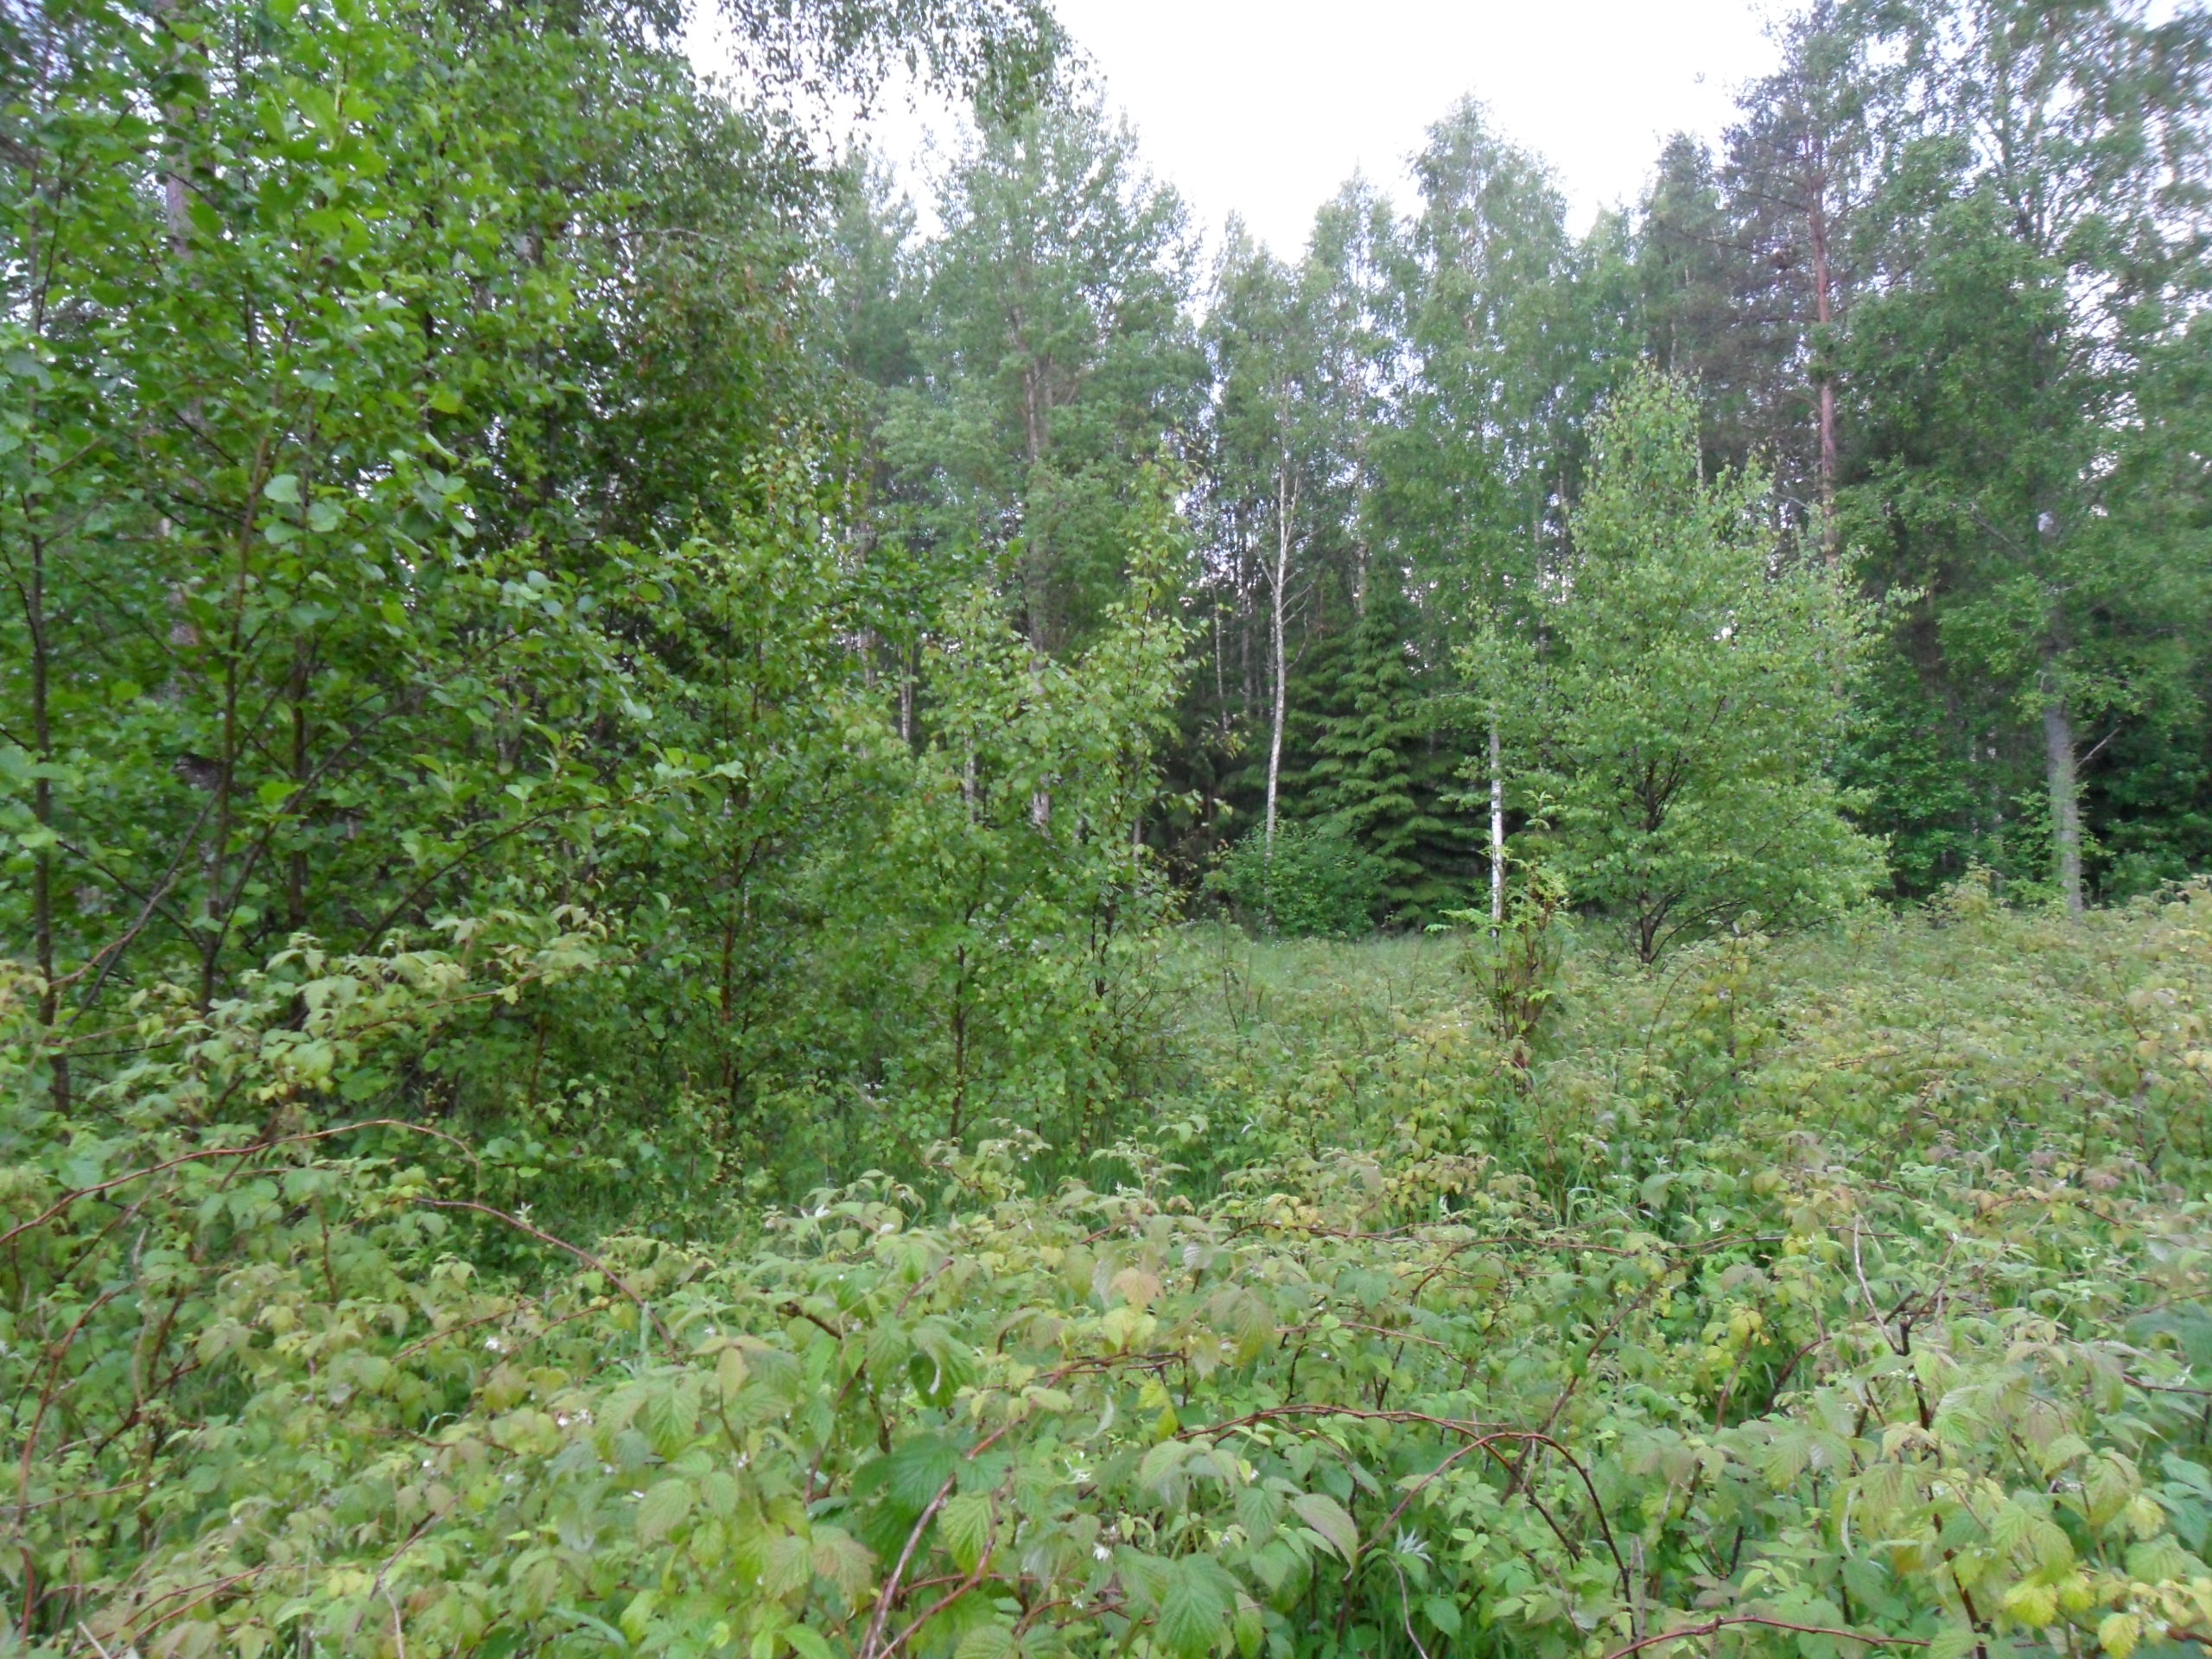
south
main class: Shrubland
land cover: Shrubland with sparse tree cover
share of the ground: > 75 %
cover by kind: shrubs 90 %, broadleaved forest trees 5 %, herbaceous plants 5 %
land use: Semi-natural and natural areas not in use
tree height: < 5 m
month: June
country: LV
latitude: 57.5026
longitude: 21.9430
